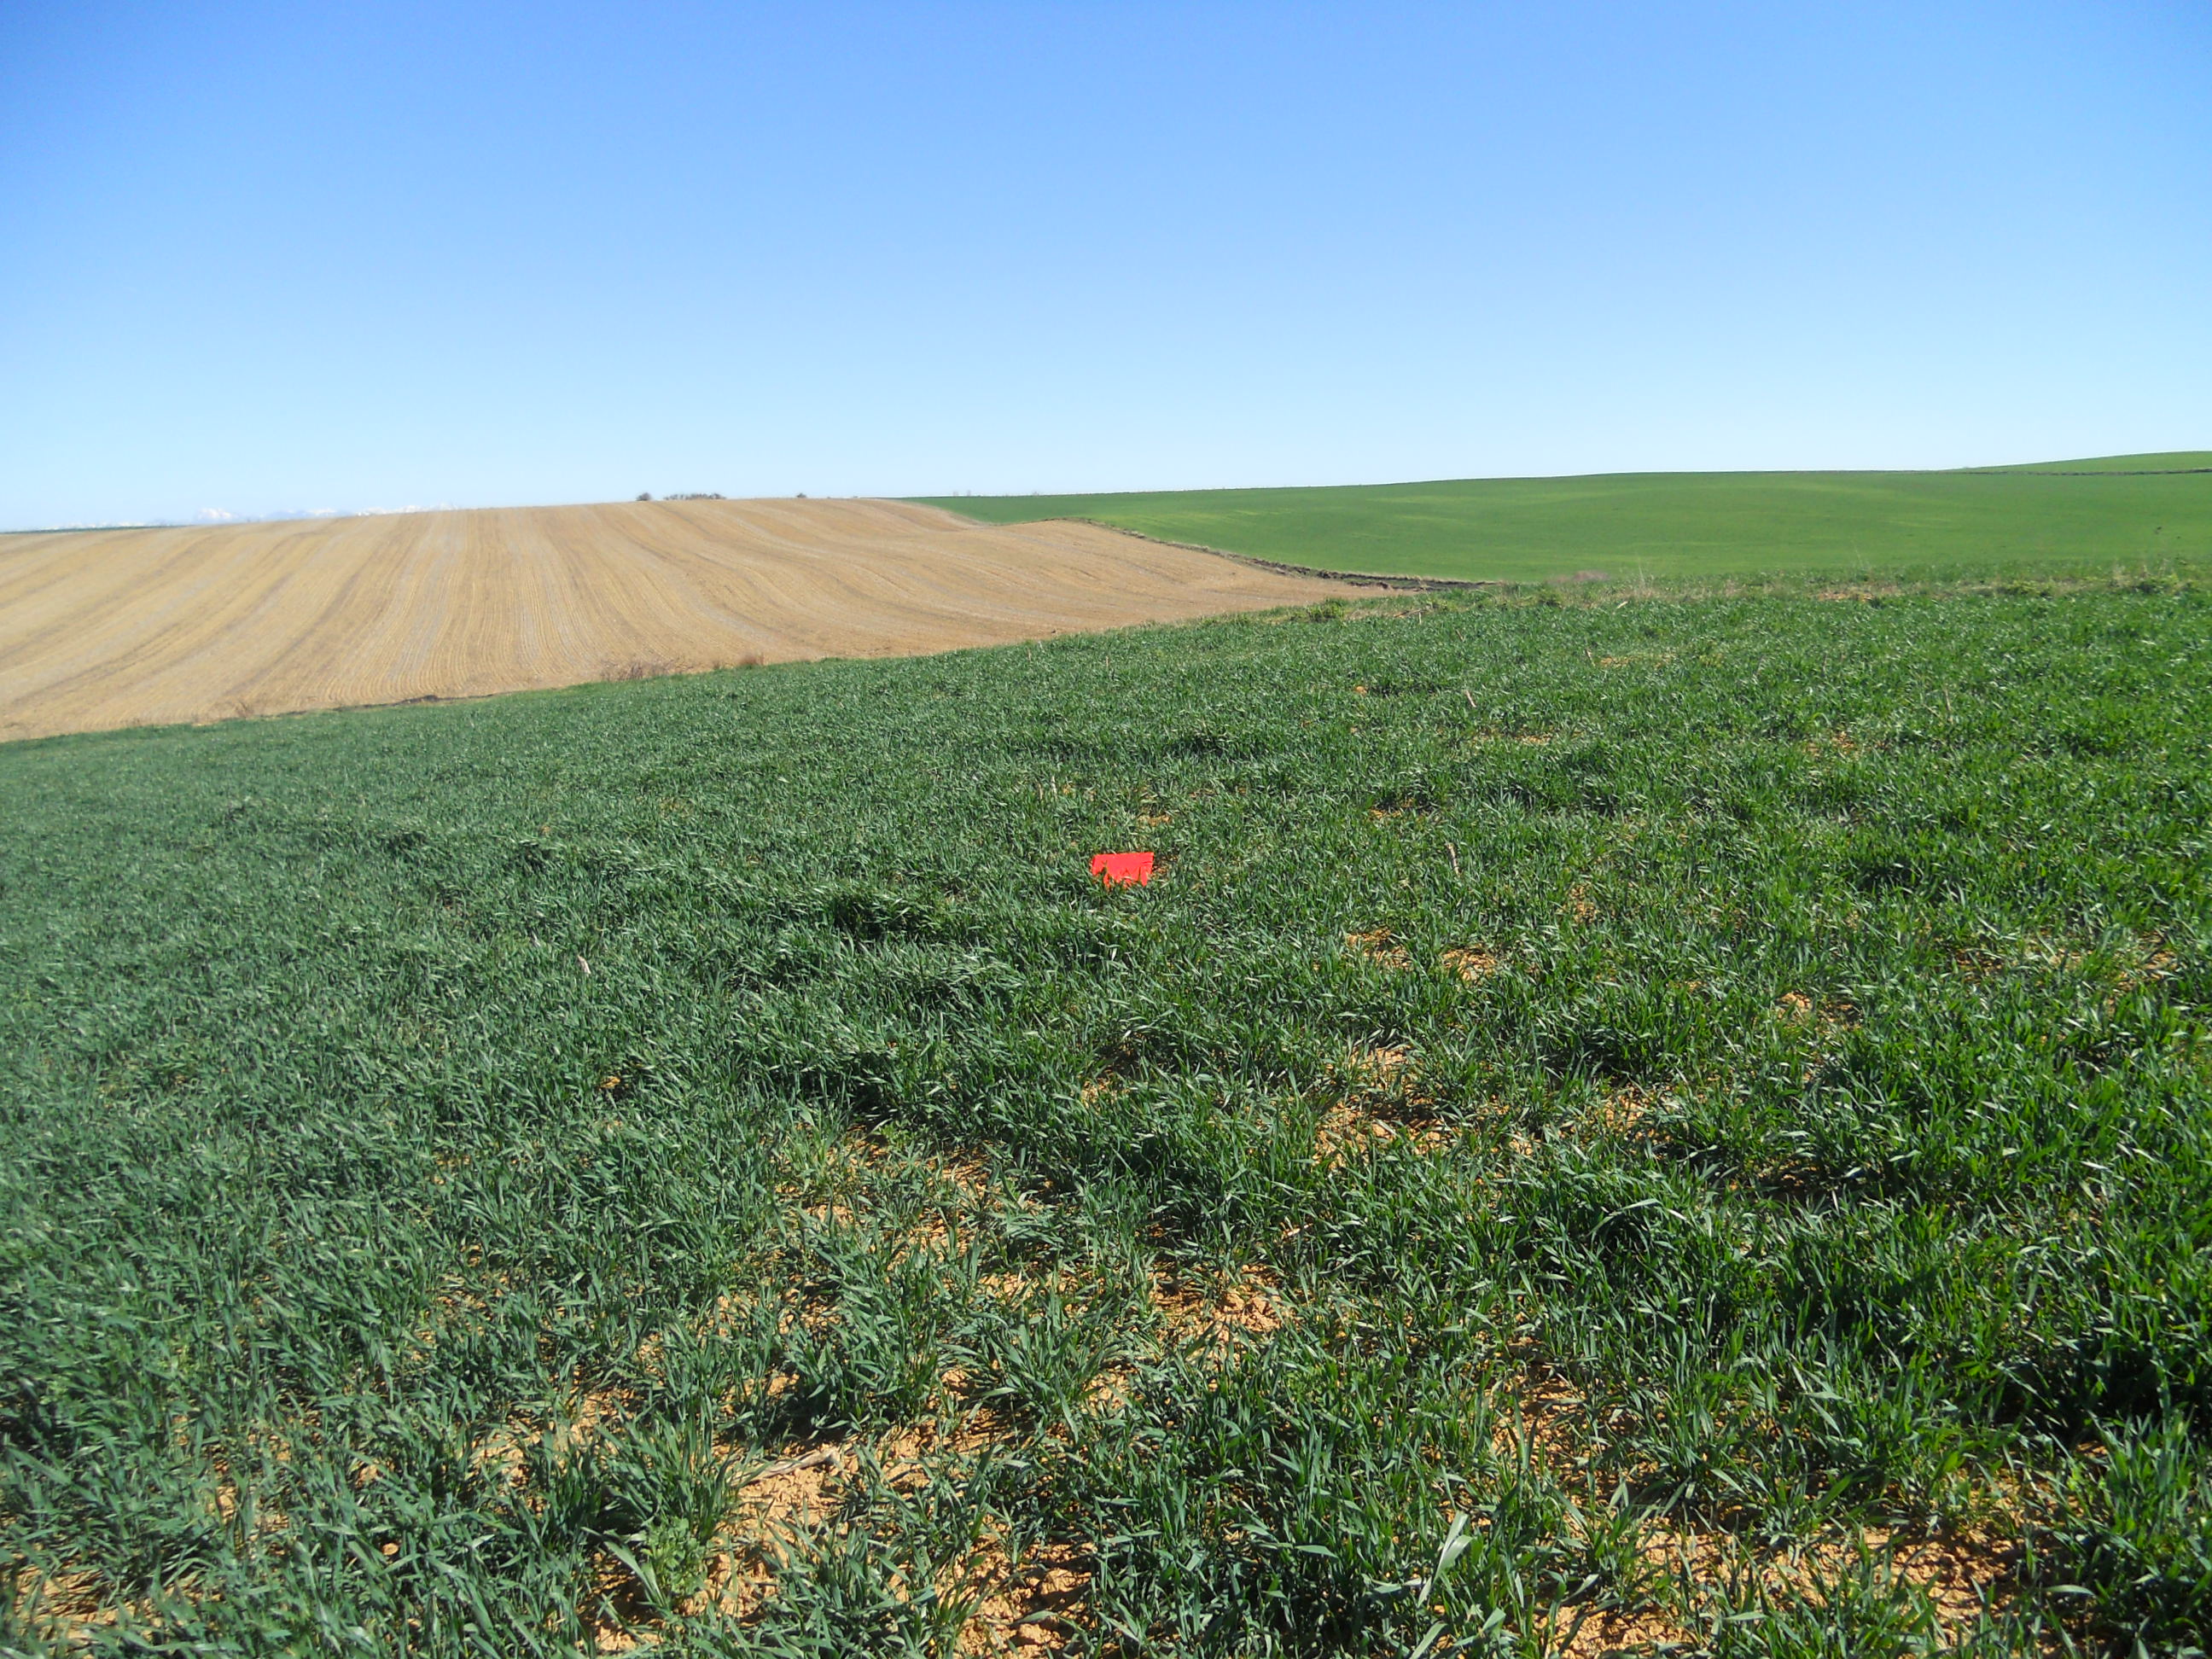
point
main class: Cropland
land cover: Common wheat
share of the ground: > 75 %
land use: Agriculture (excluding fallow land and kitchen gardens)
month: April
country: ES
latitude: 42.2520
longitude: -4.8293
